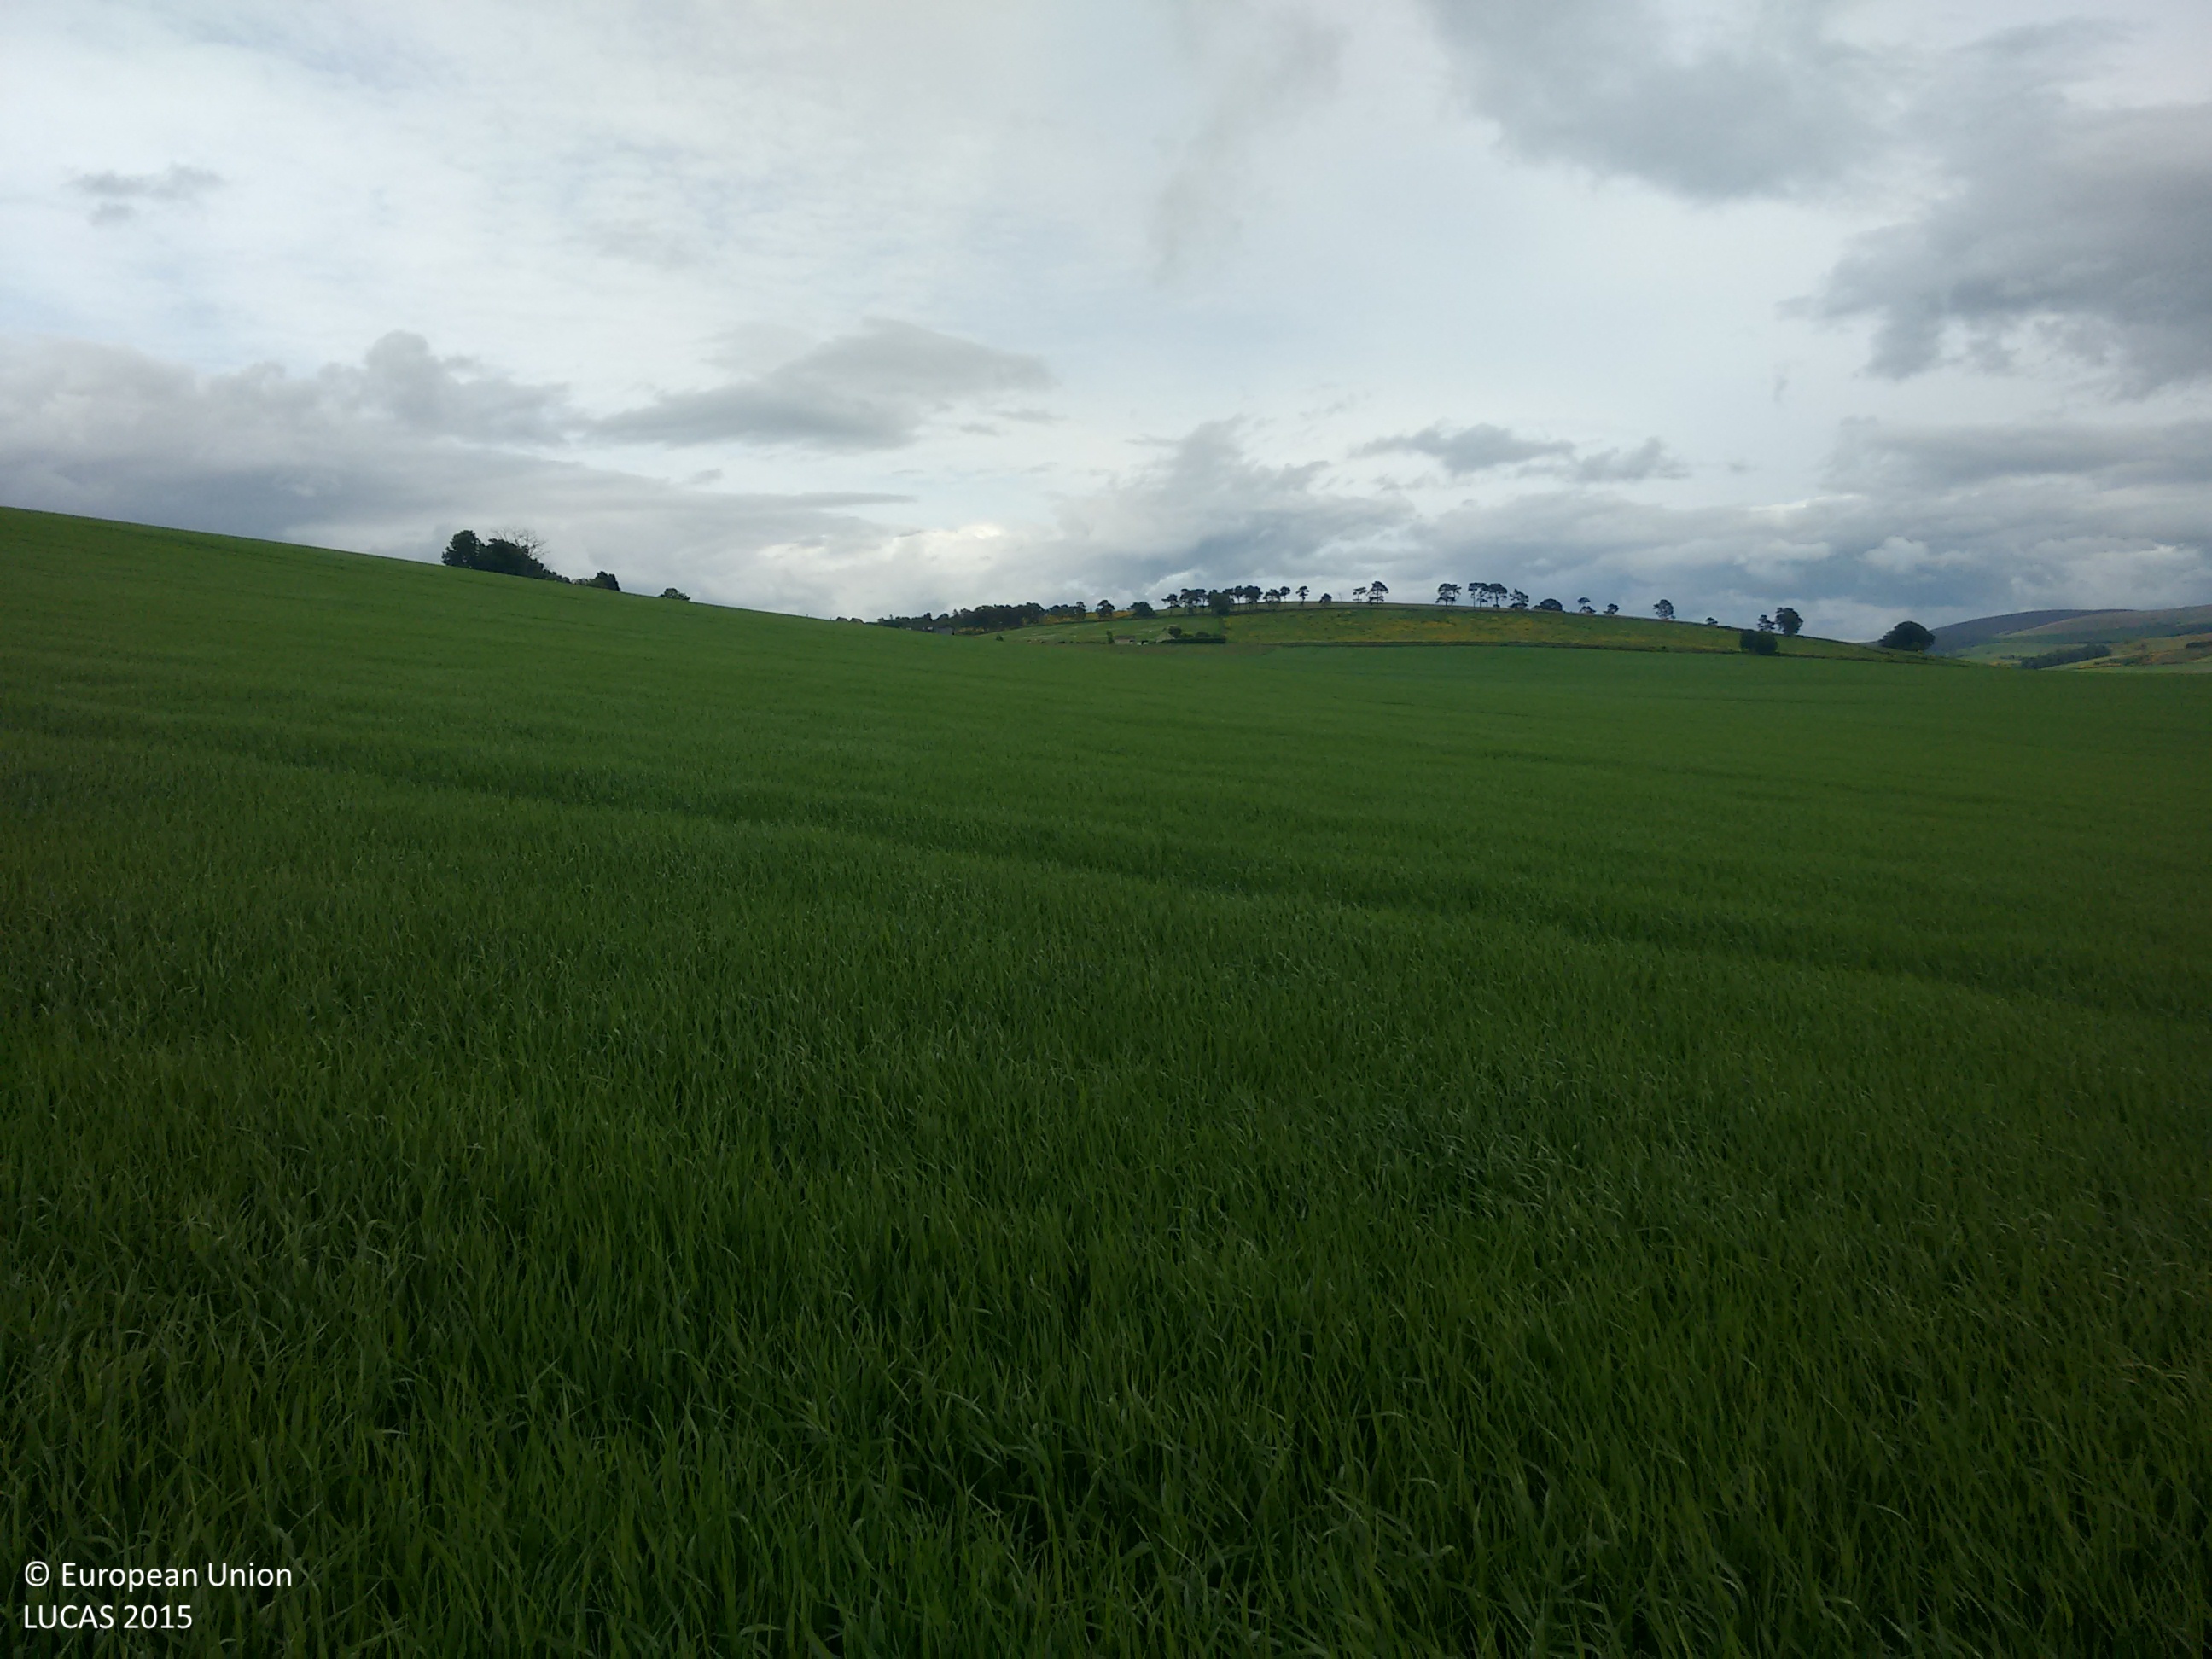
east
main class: Cropland
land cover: Barley
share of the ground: > 75 %
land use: Agriculture (excluding fallow land and kitchen gardens)
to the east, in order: Barley
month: June
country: GB
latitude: 57.2103
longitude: -2.7233
